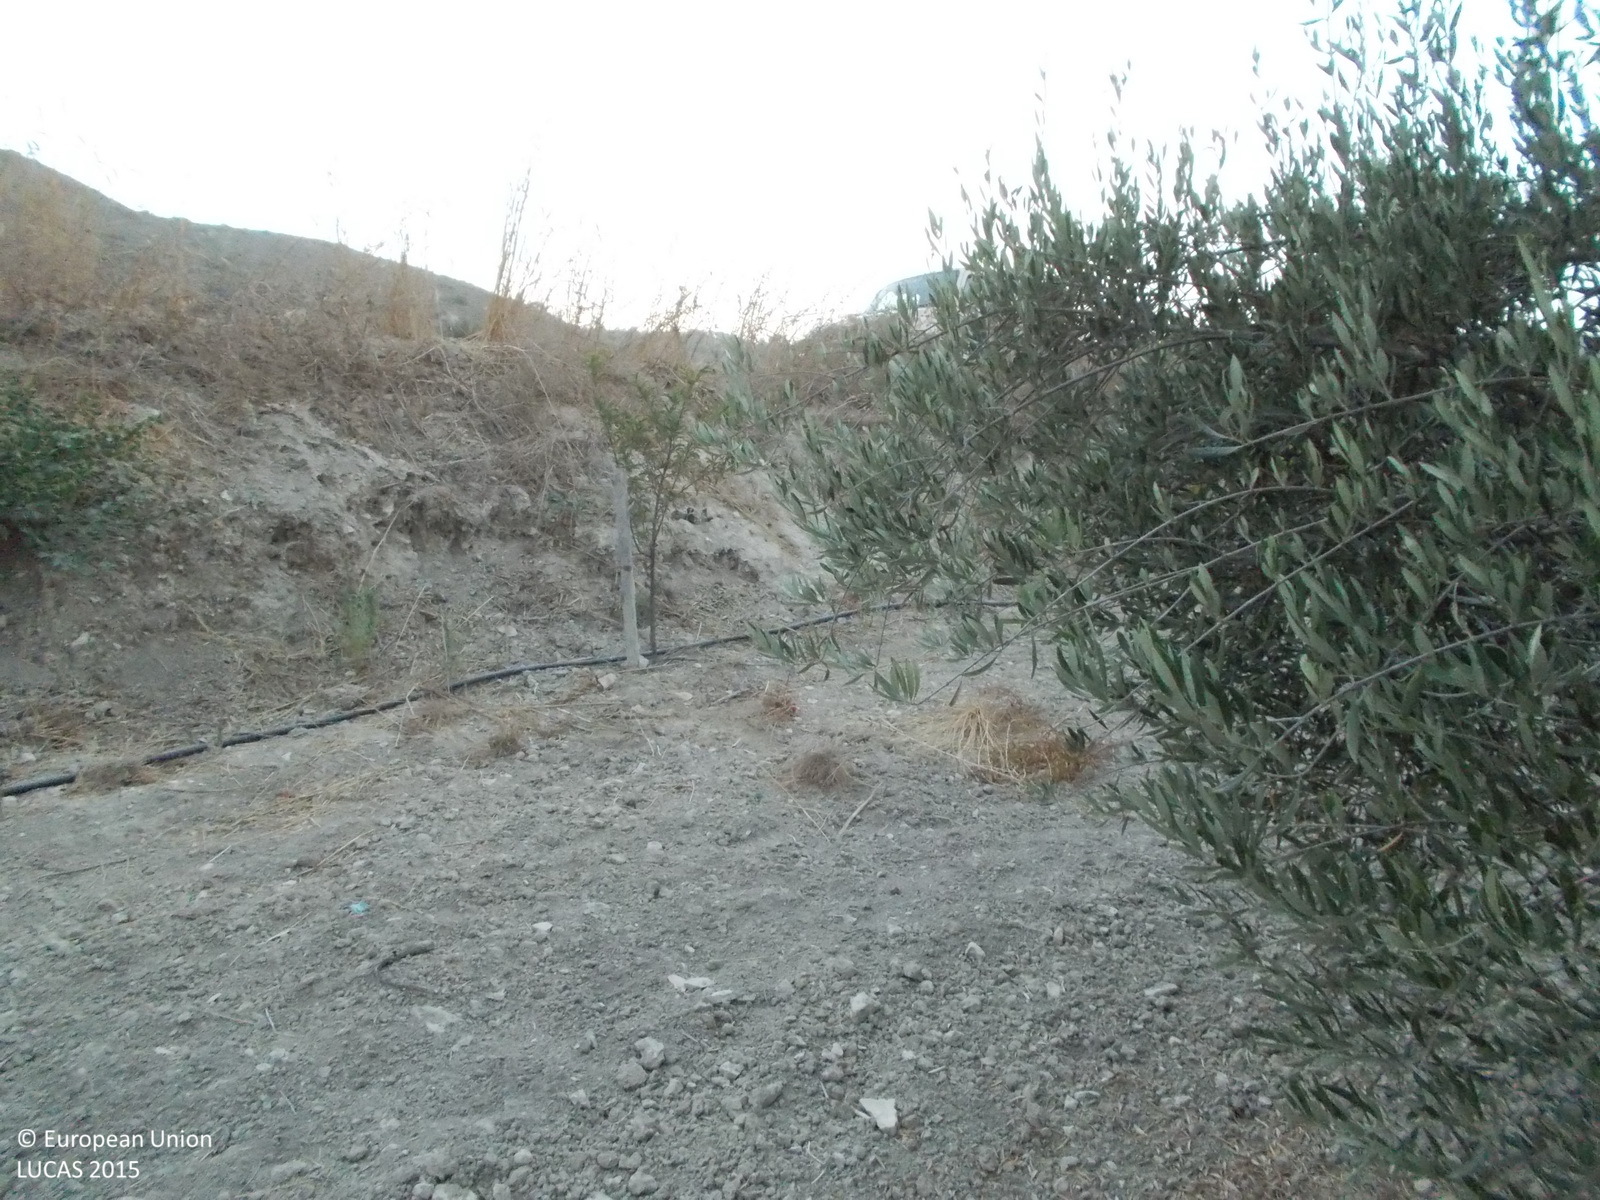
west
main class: Cropland
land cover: Olive groves
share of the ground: > 75 %
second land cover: Other bare soil
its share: > 75 %
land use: Agriculture (excluding fallow land and kitchen gardens)
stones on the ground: < 10 %
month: May
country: CY
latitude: 34.7879
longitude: 33.3150
